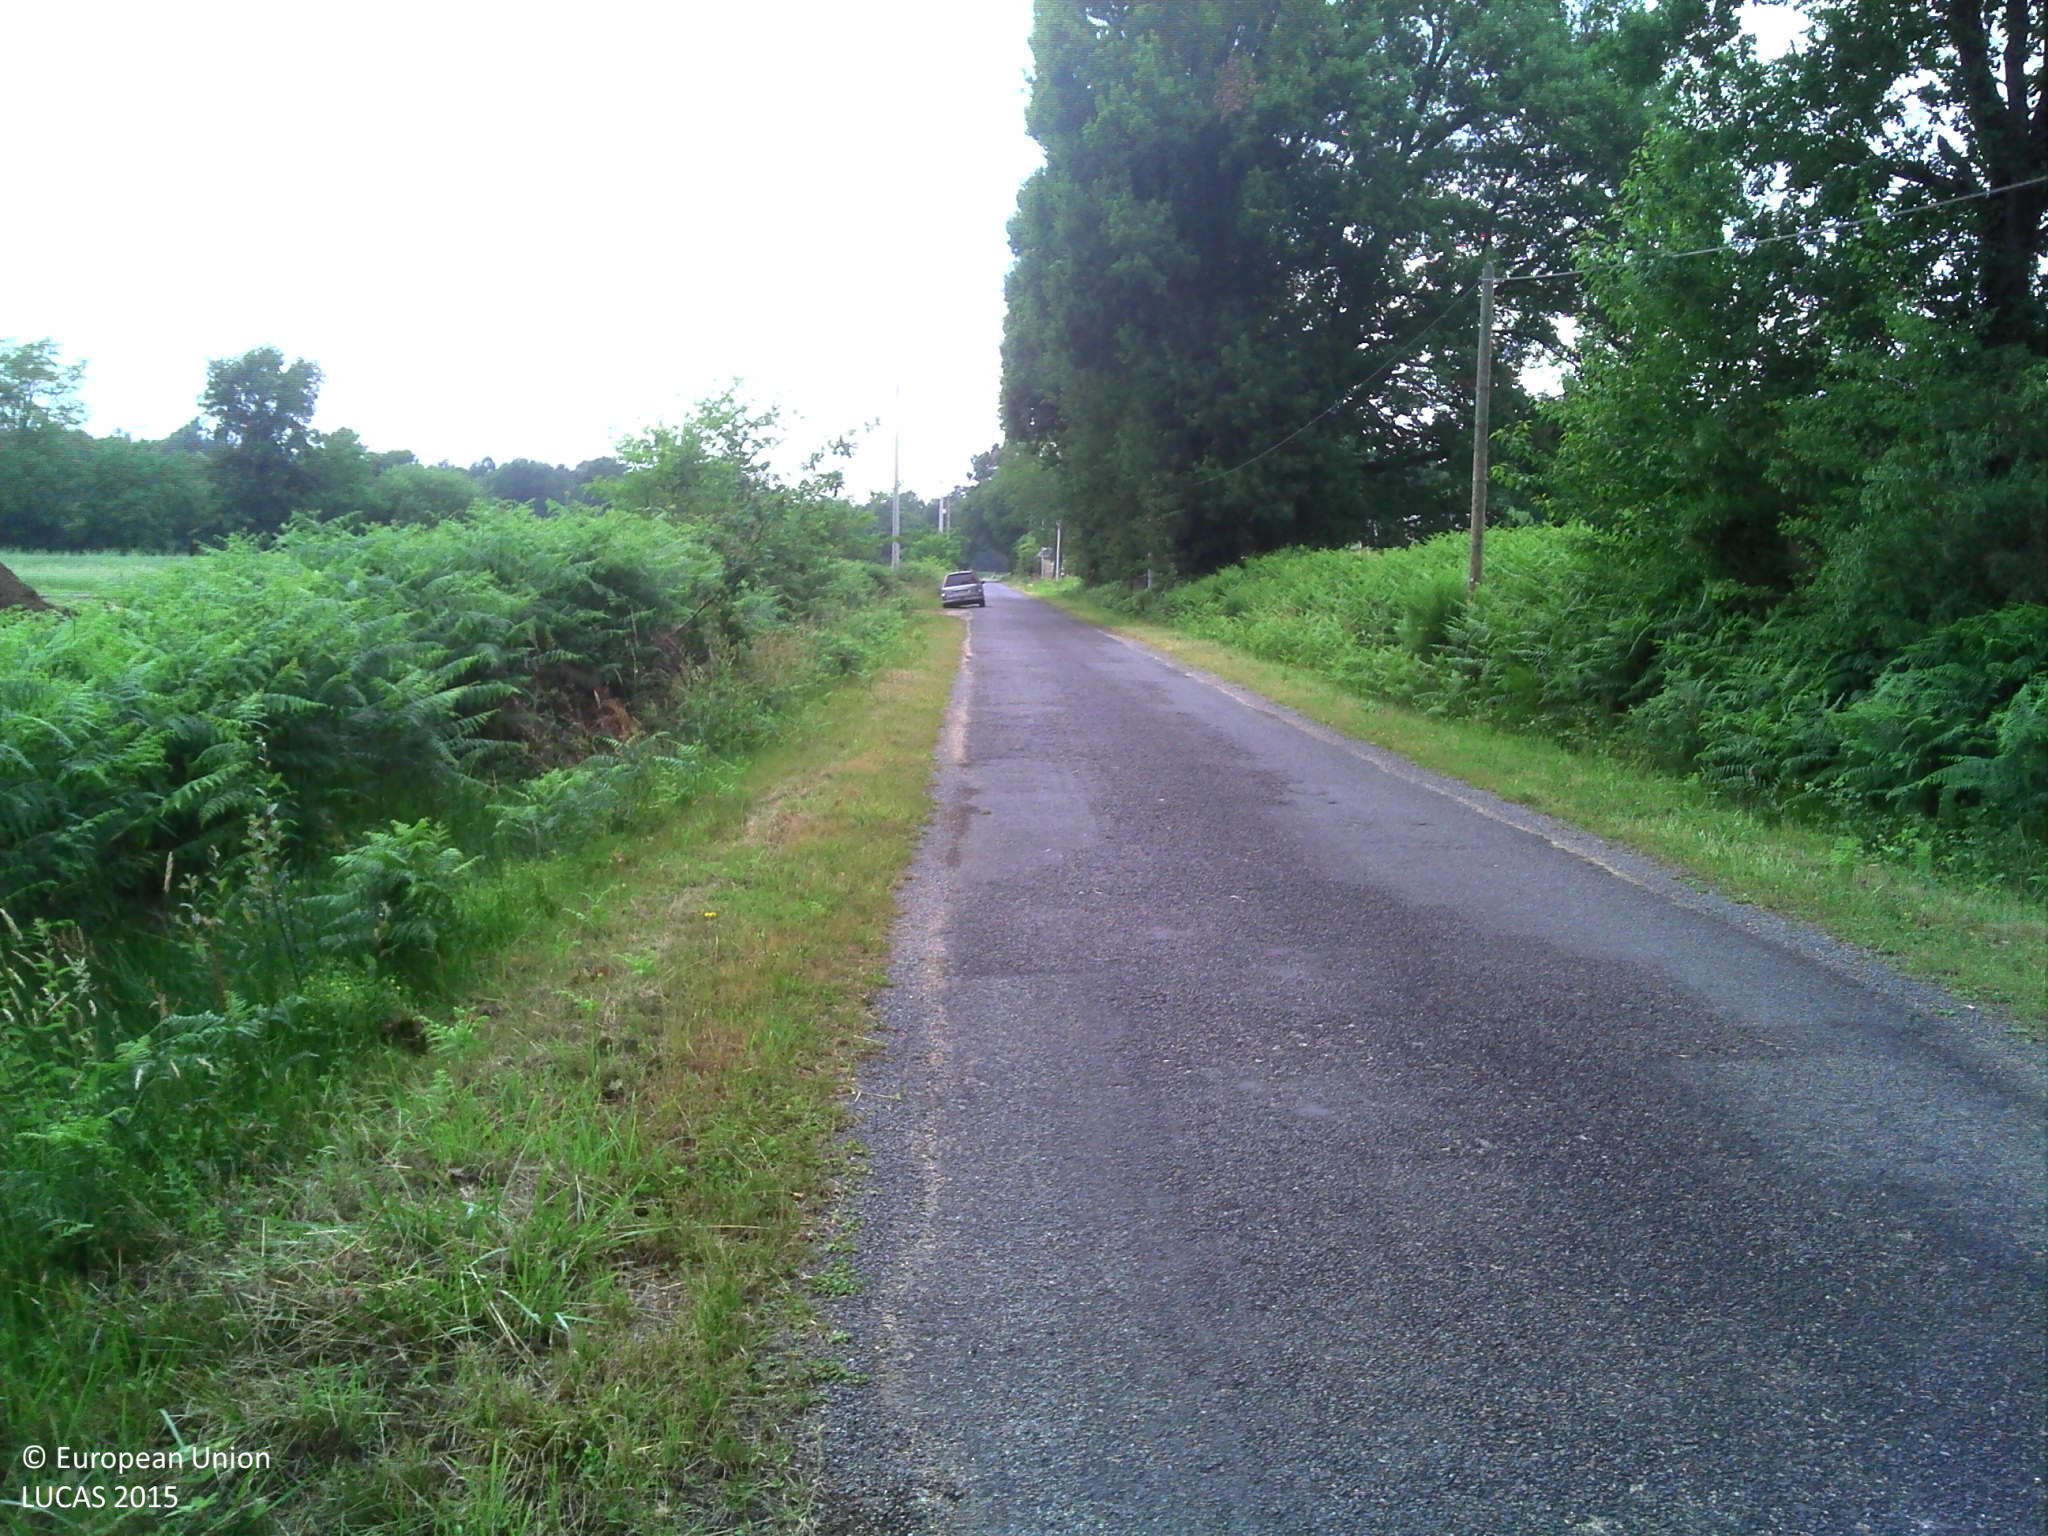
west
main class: Cropland
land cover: Nurseries
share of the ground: > 75 %
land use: Agriculture (excluding fallow land and kitchen gardens)
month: June
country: FR
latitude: 47.4250
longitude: 0.0190
